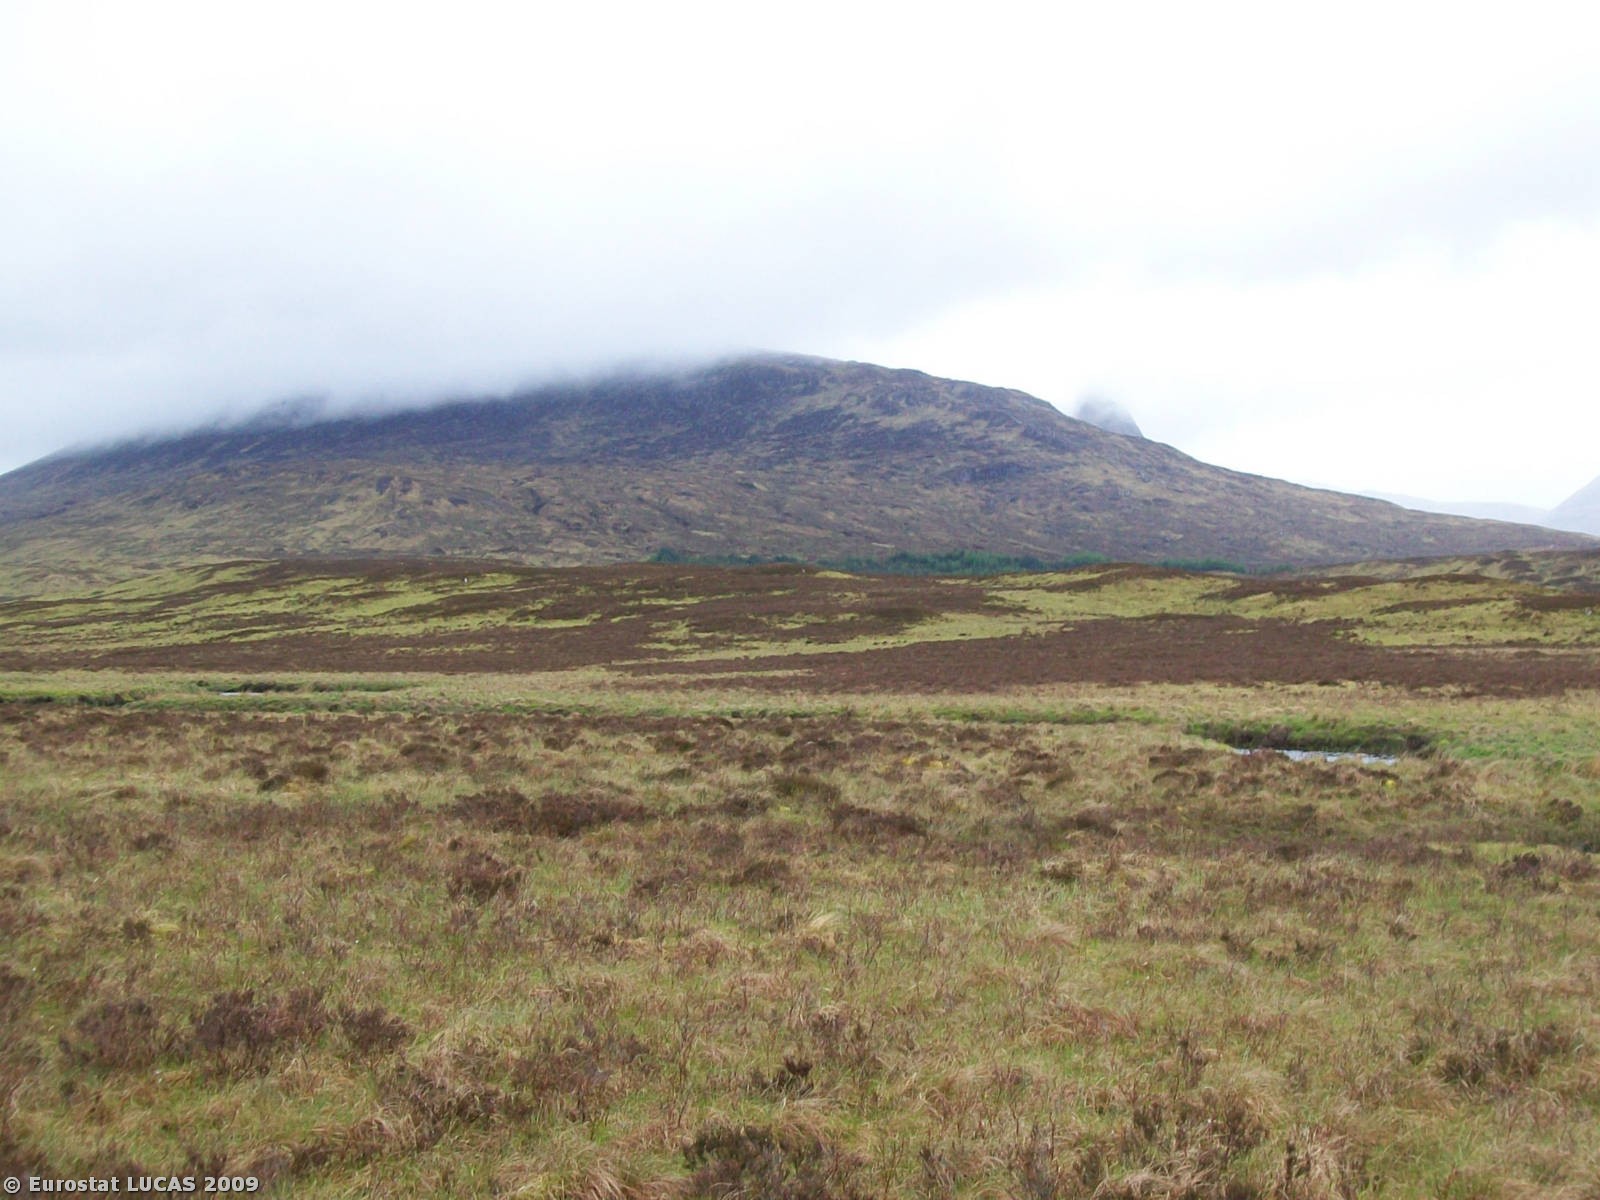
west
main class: Shrubland
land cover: Shrubland without tree cover
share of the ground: > 75 %
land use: Nature reserves
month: May
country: GB
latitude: 56.5723
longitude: -4.7667
